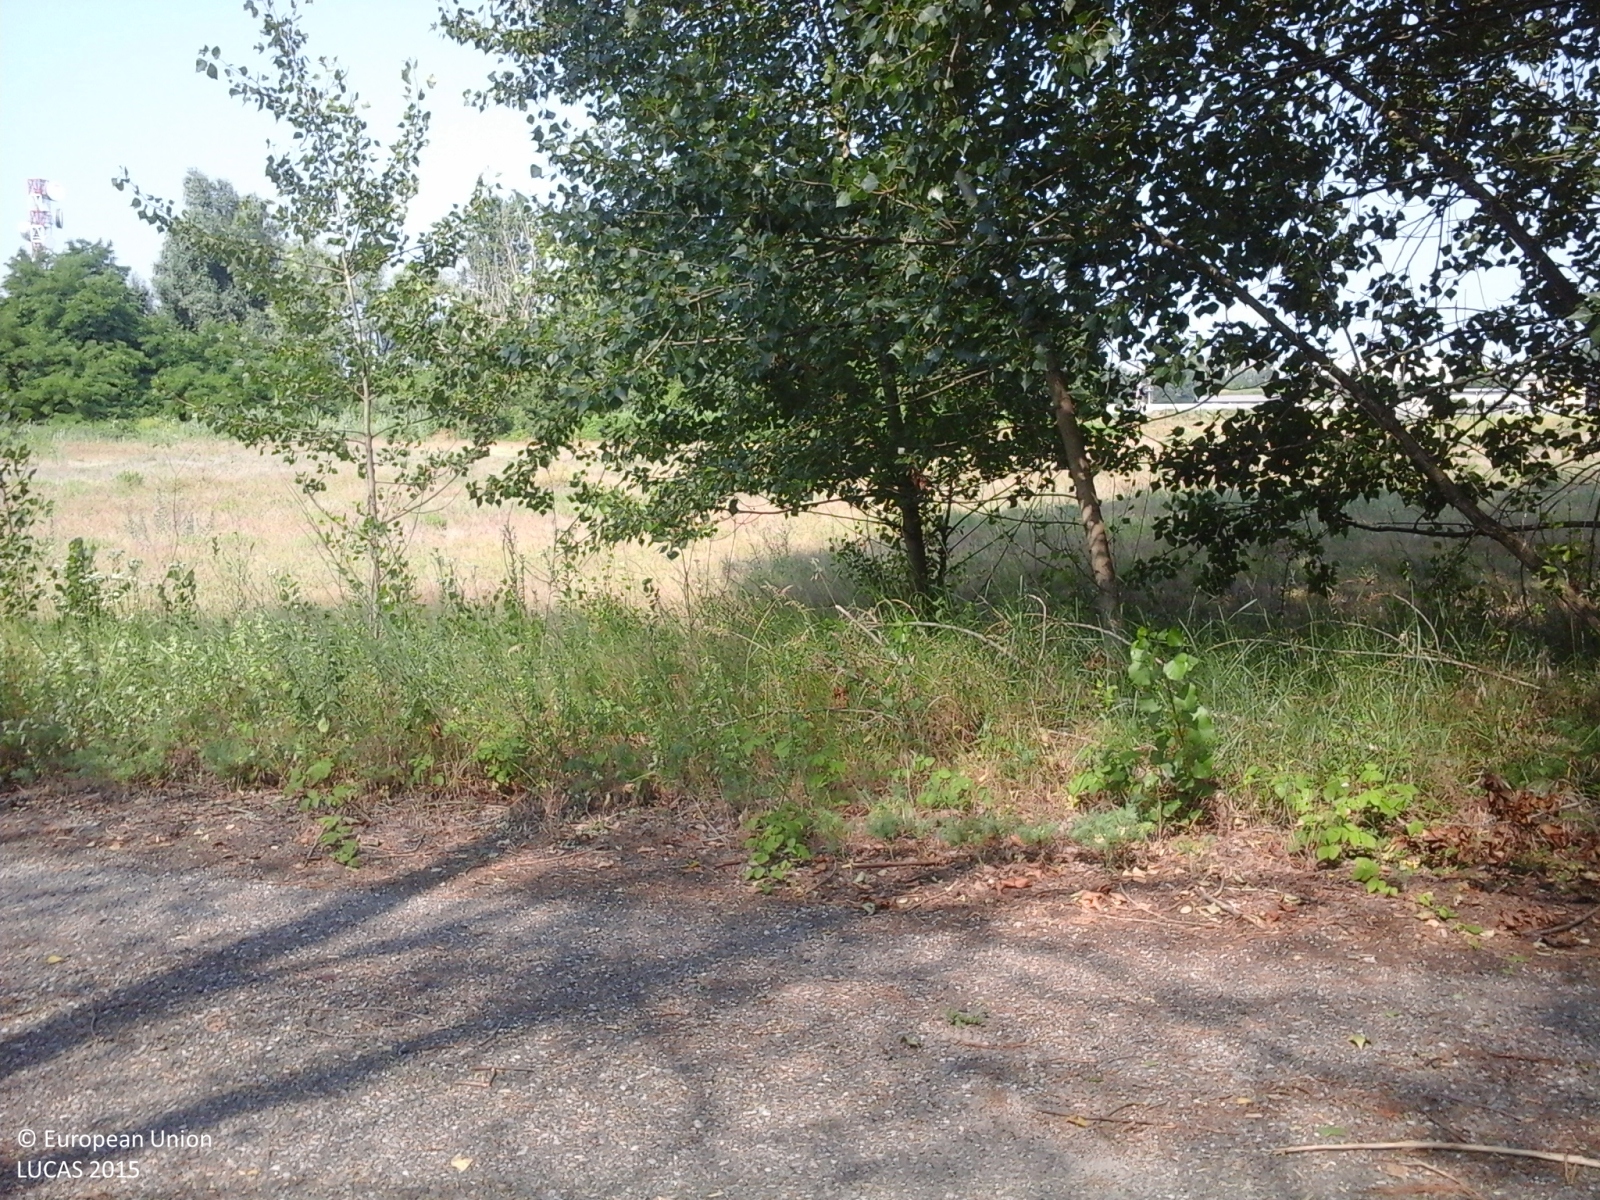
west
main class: Woodland
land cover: Broadleaved woodland
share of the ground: > 75 %
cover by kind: broadleaved forest trees 100 %
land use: Semi-natural and natural areas not in use
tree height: > 5 m
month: June
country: IT
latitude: 45.1439
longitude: 9.9619
